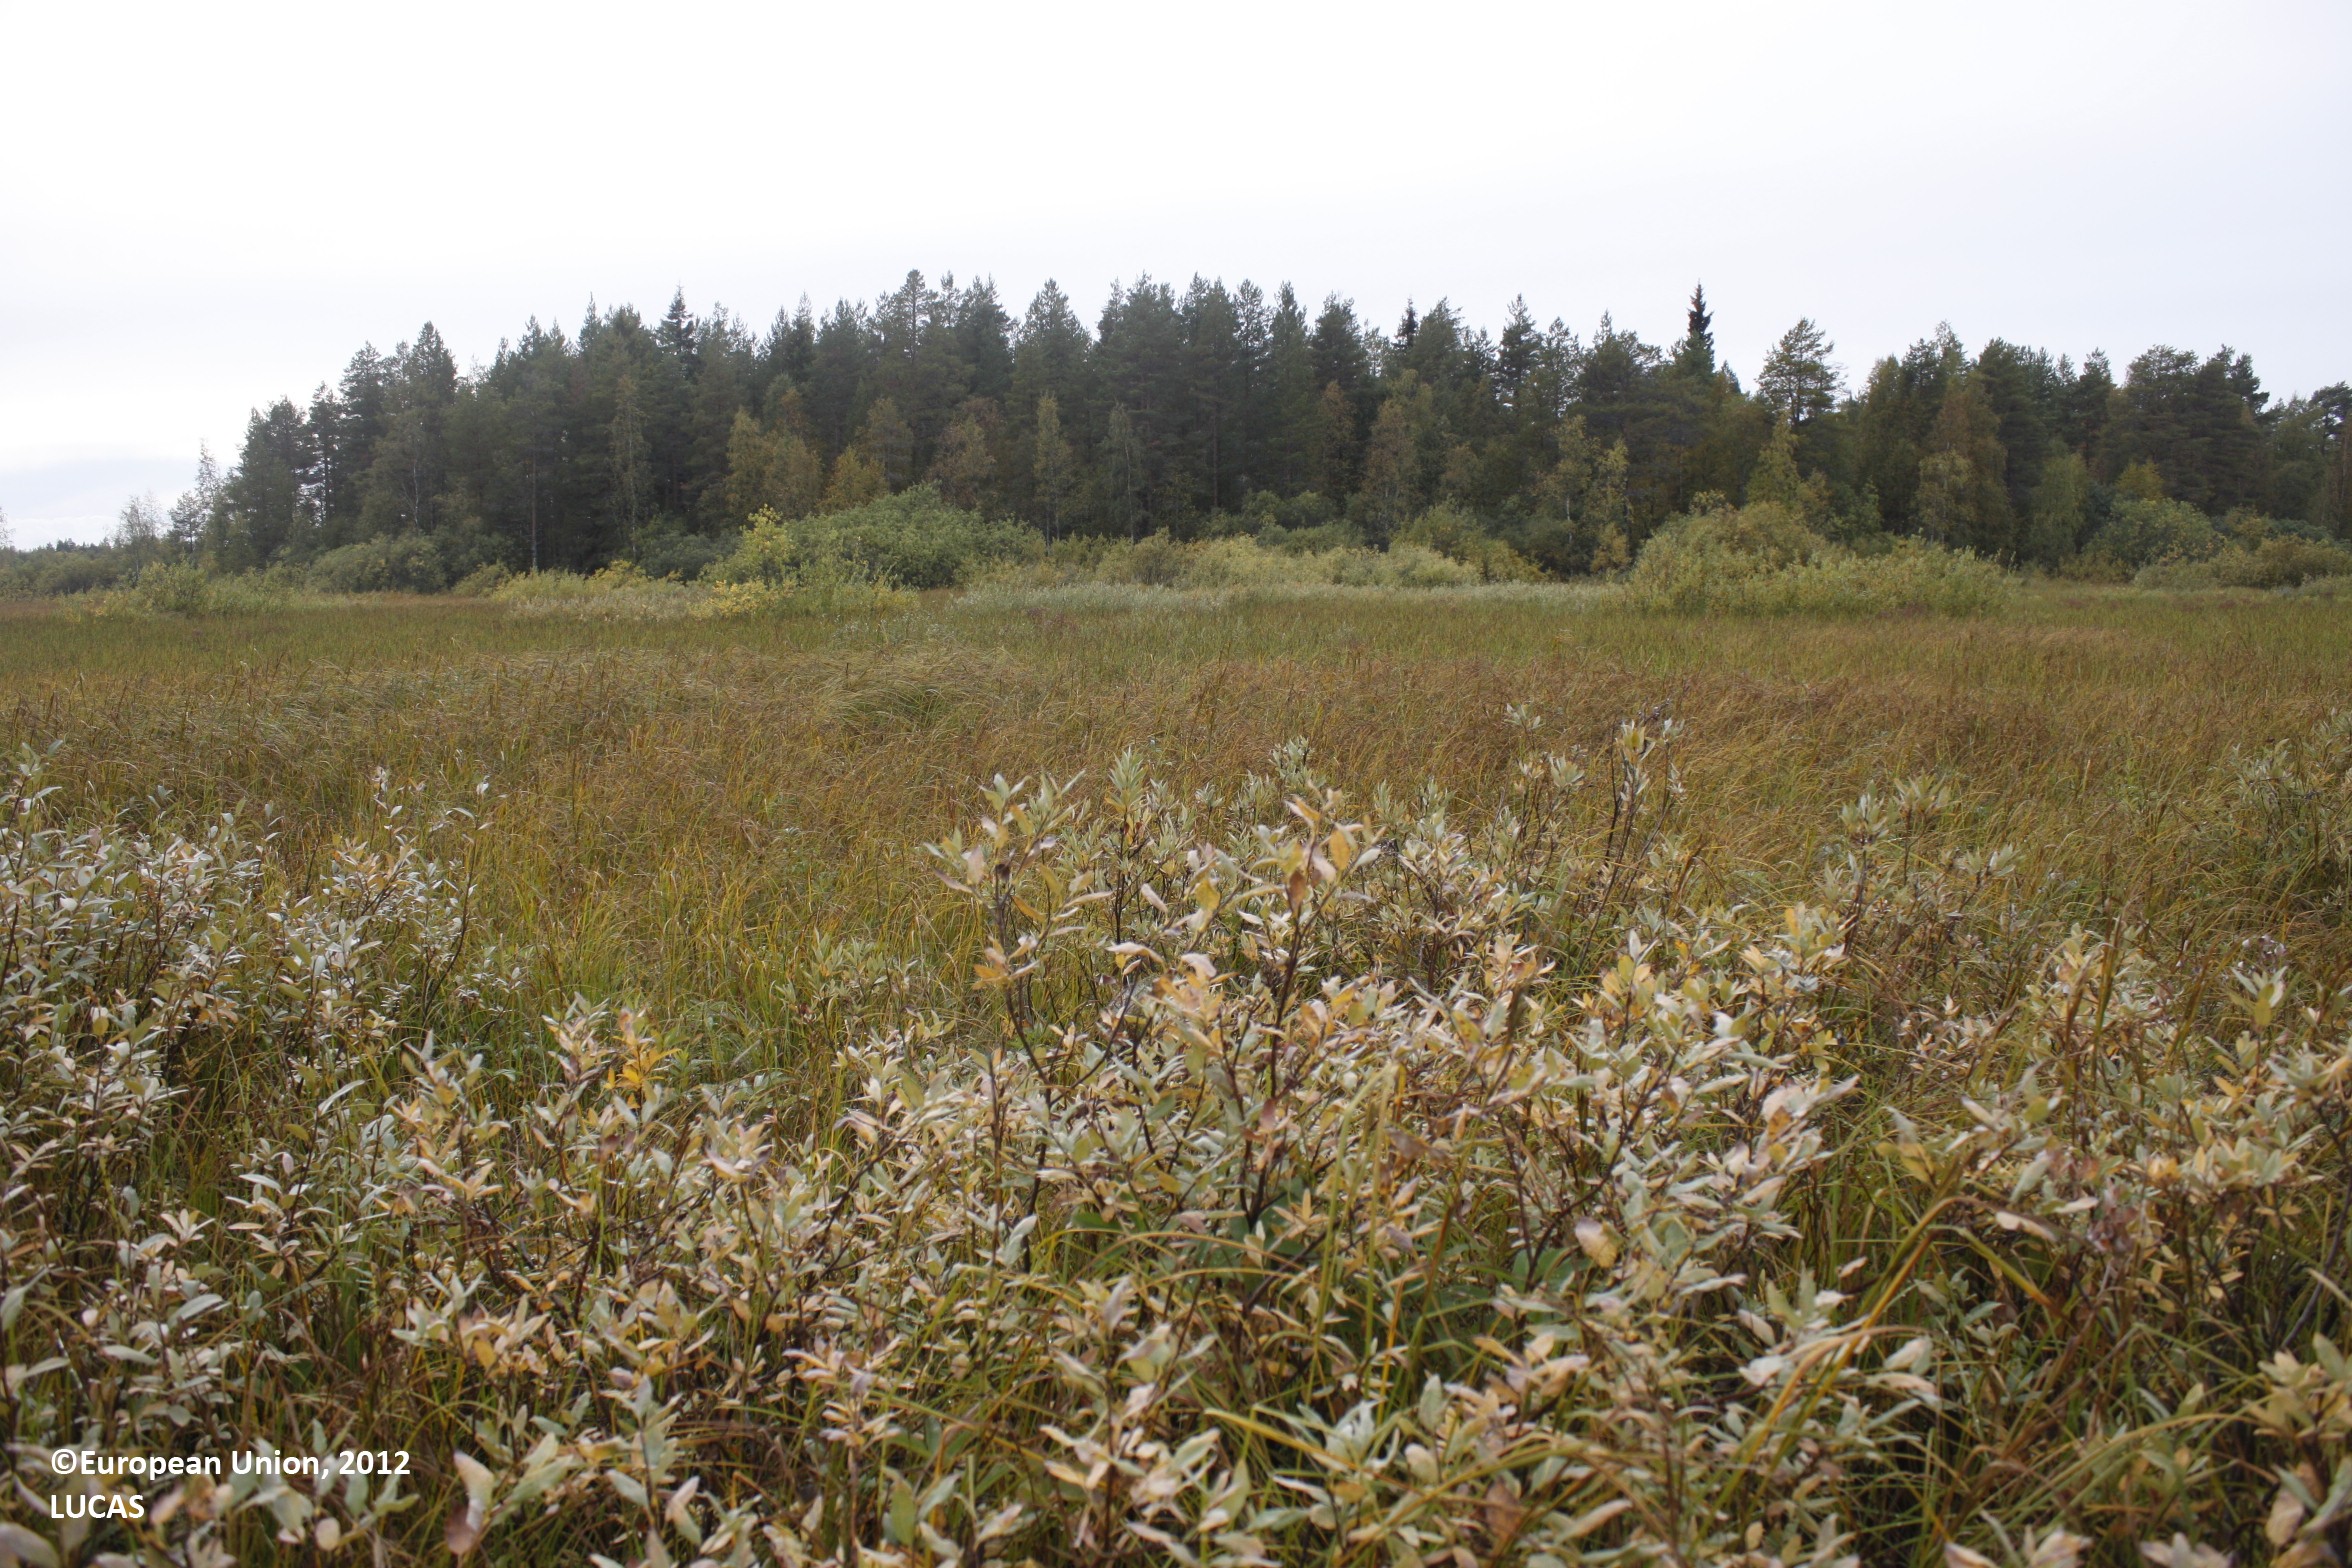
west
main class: Woodland
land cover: Pine dominated mixed woodland
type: mire and swamp forests
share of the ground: 50 - 75 %
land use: Forestry
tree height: > 5 m
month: September
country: FI
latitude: 65.3144
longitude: 26.9617
